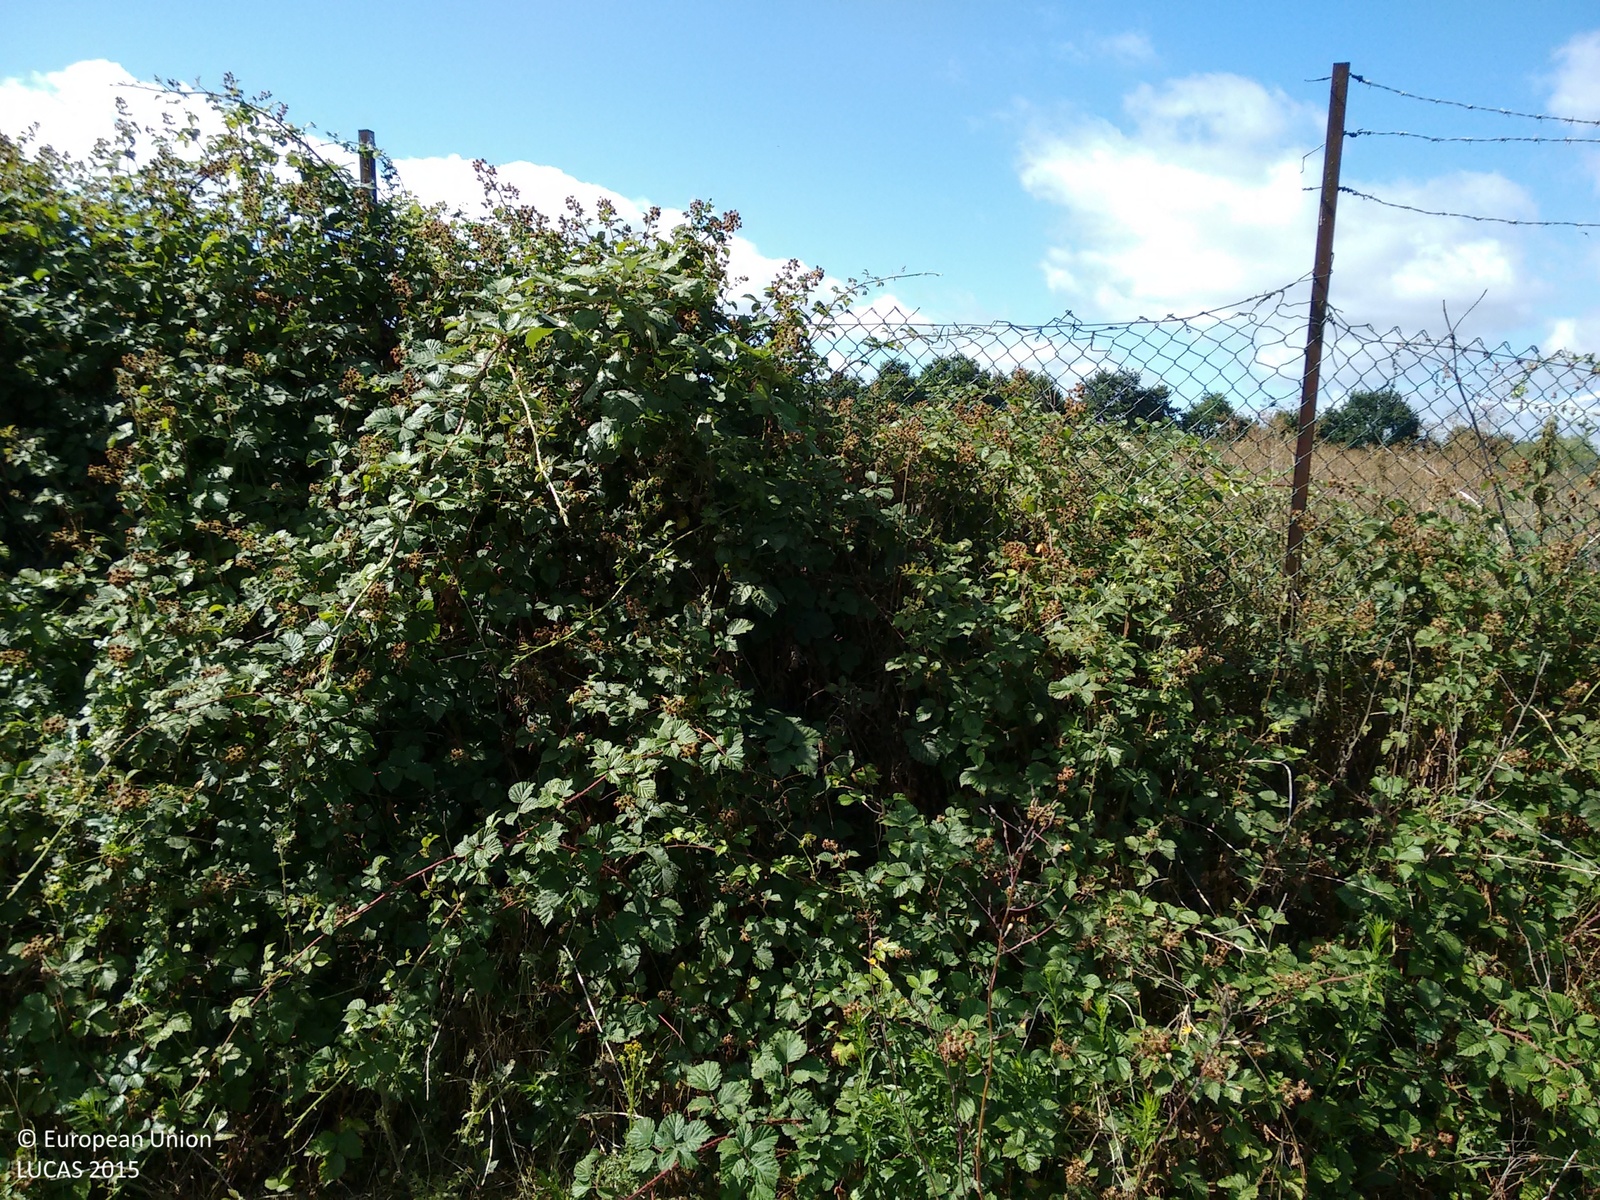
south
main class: Shrubland
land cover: Shrubland without tree cover
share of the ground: > 75 %
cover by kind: shrubs 50 %, herbaceous plants 40 %, consolidated bare surface 10 %
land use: Fallow land
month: July
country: GB
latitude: 51.3986
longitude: -0.5460
